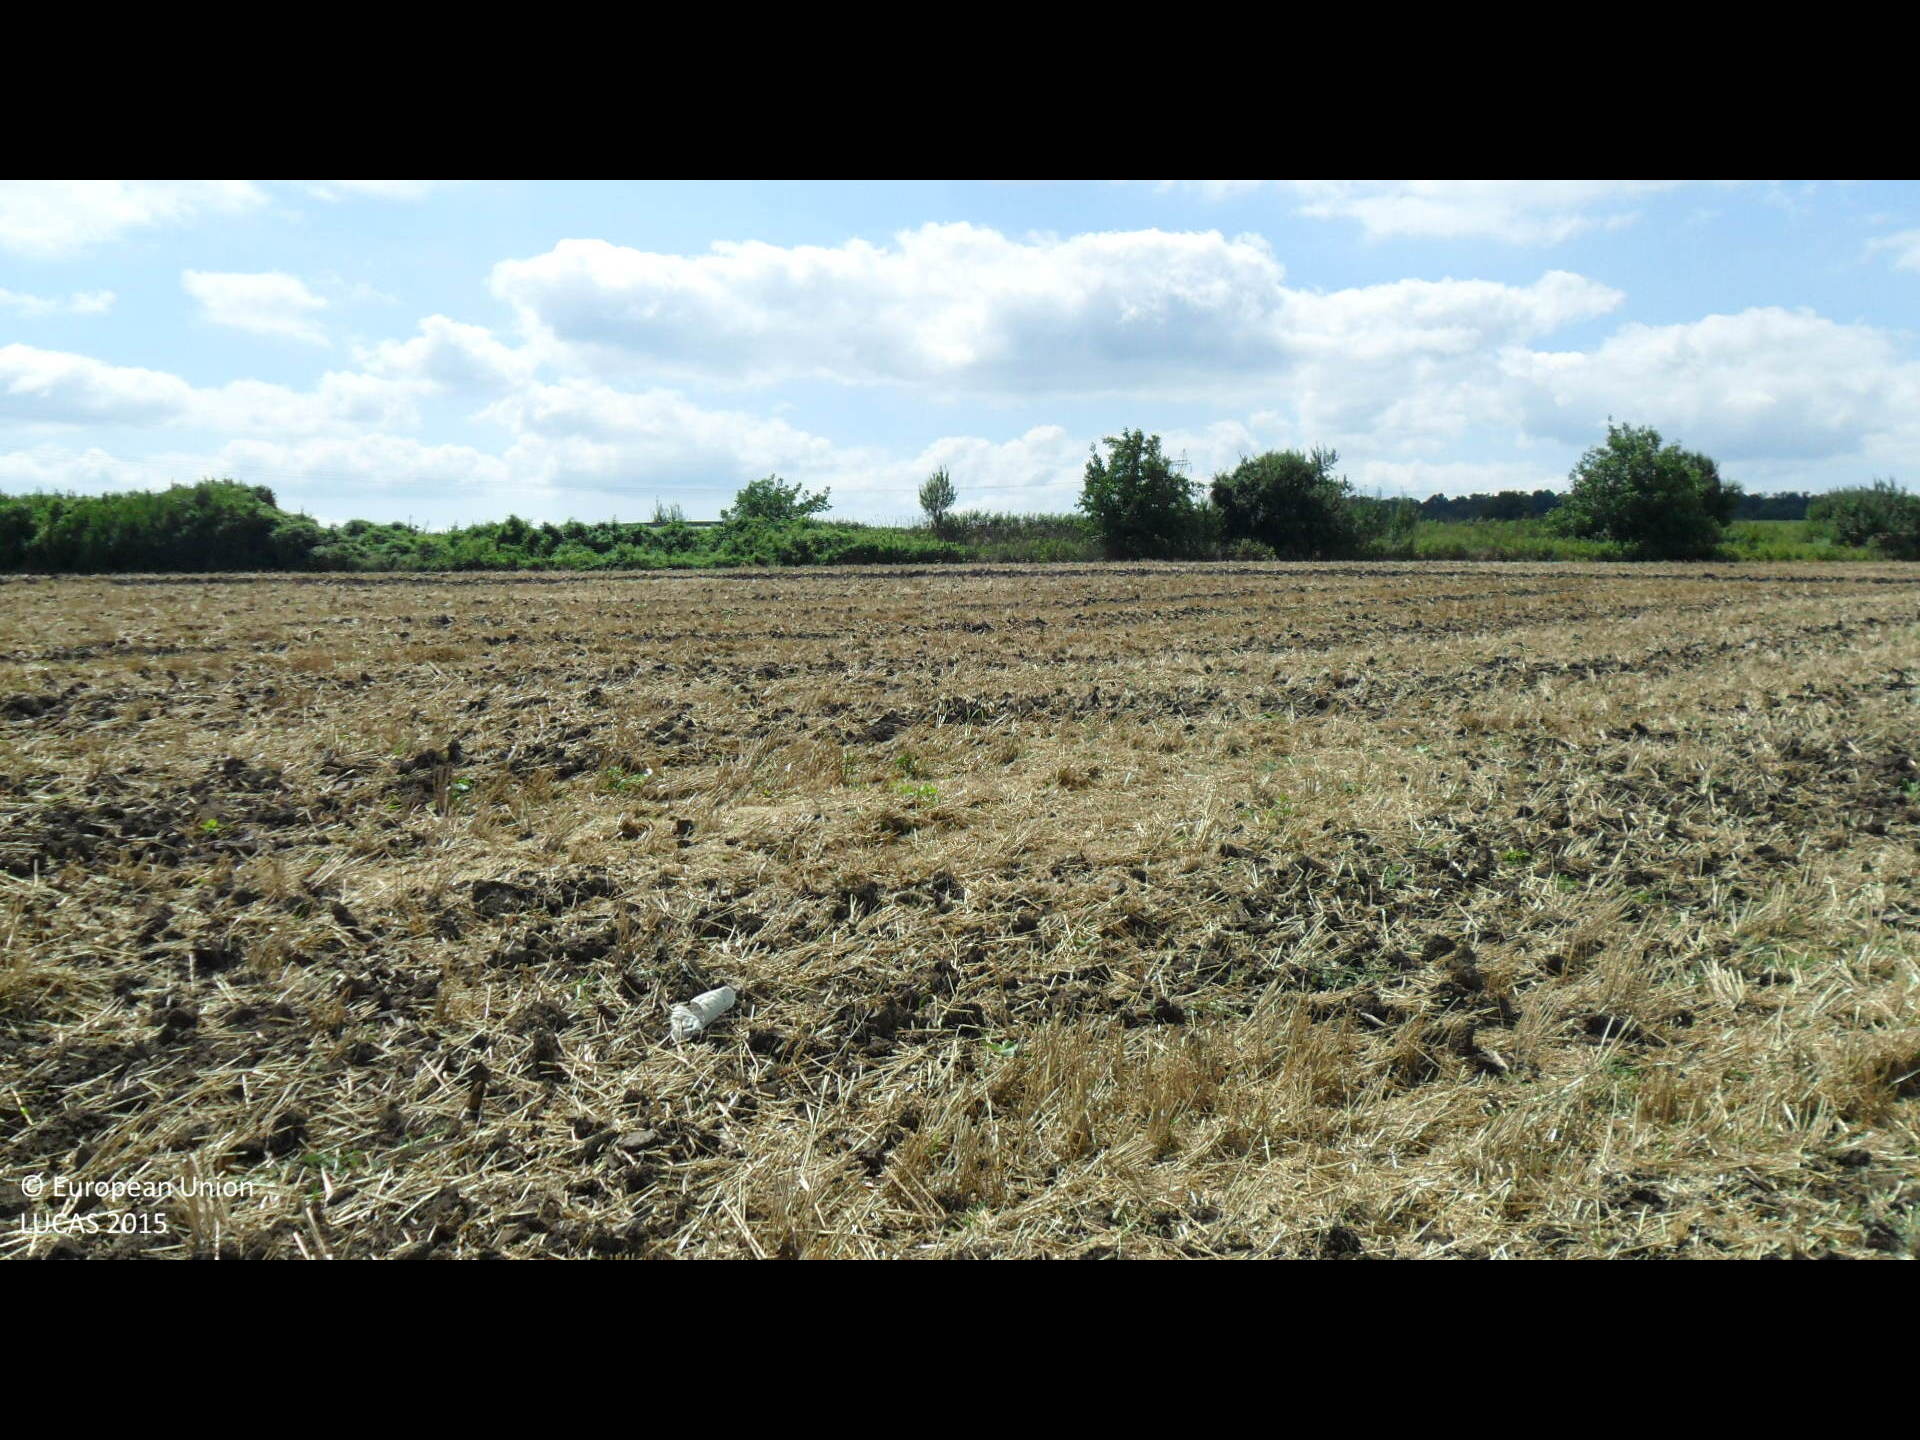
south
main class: Cropland
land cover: Common wheat
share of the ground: 25 - 50 %
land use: Agriculture (excluding fallow land and kitchen gardens)
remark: Harvested field
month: August
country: BG
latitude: 43.4435
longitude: 26.3737
